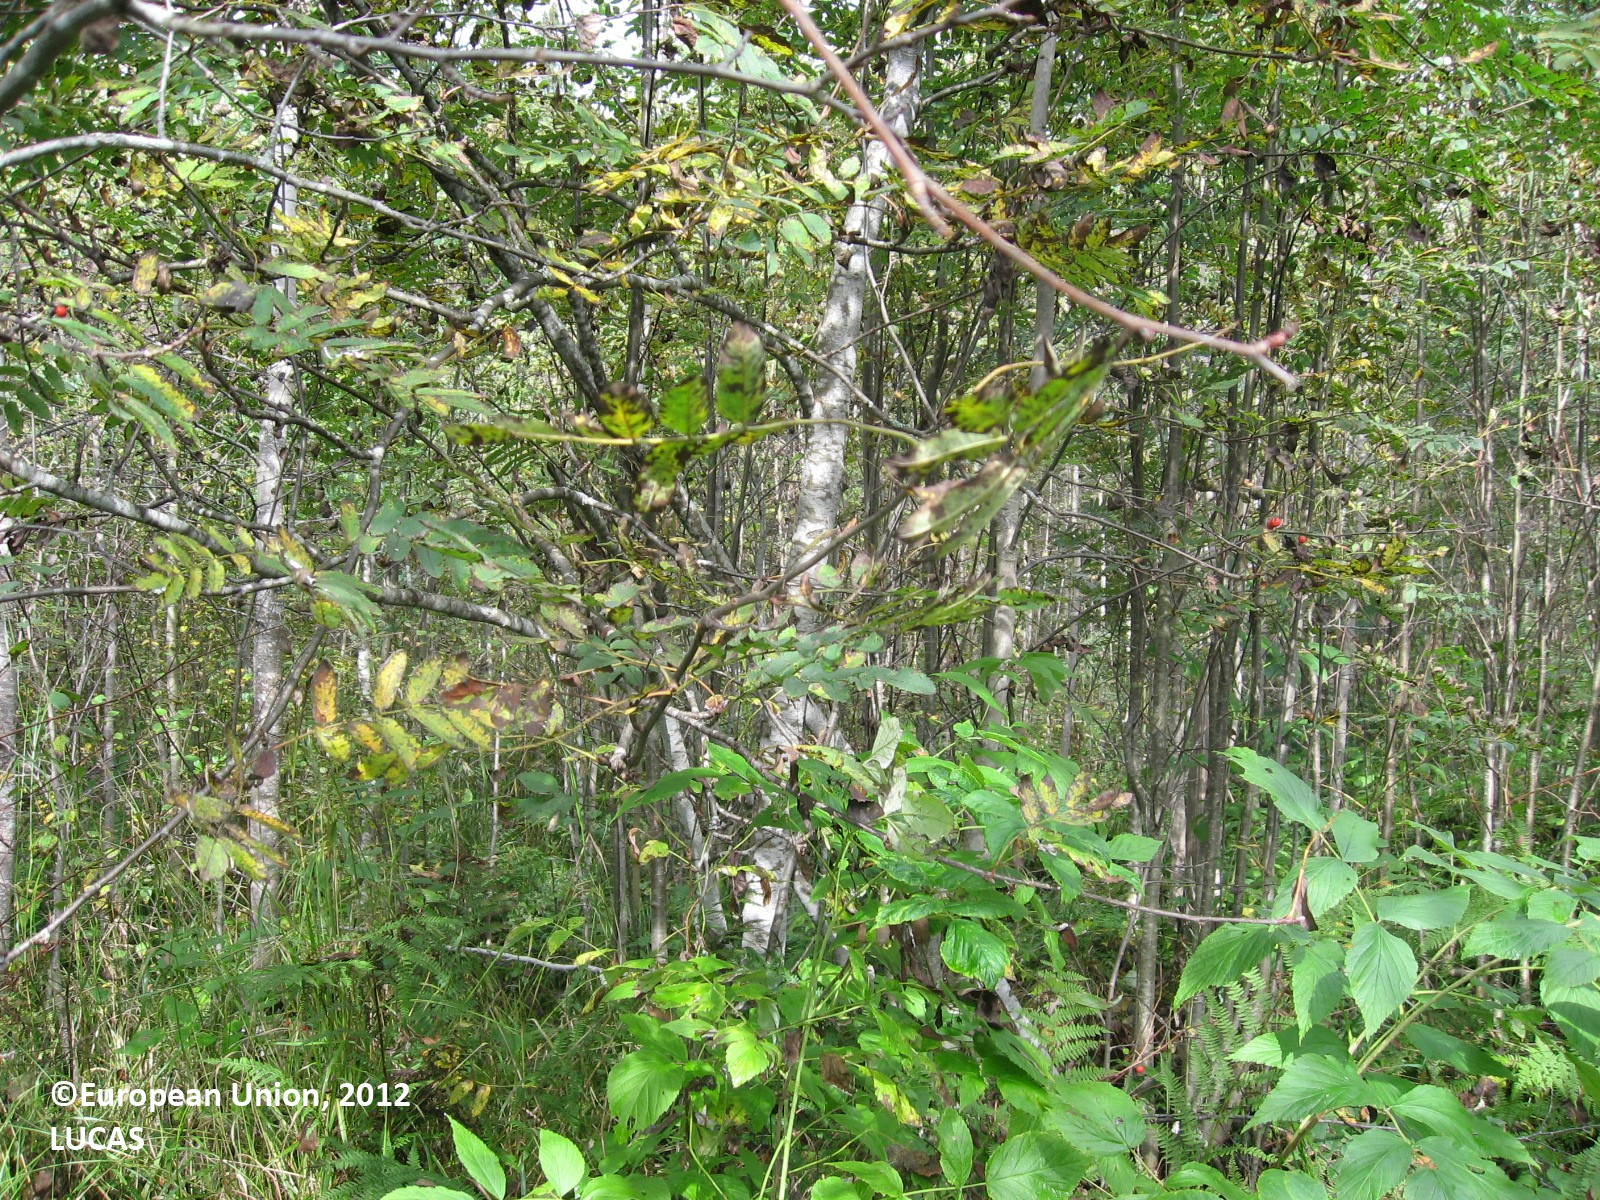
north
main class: Woodland
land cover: Broadleaved woodland
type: boreal forest
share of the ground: > 75 %
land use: Forestry
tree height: > 5 m
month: September
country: FI
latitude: 60.9459
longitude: 25.2378
